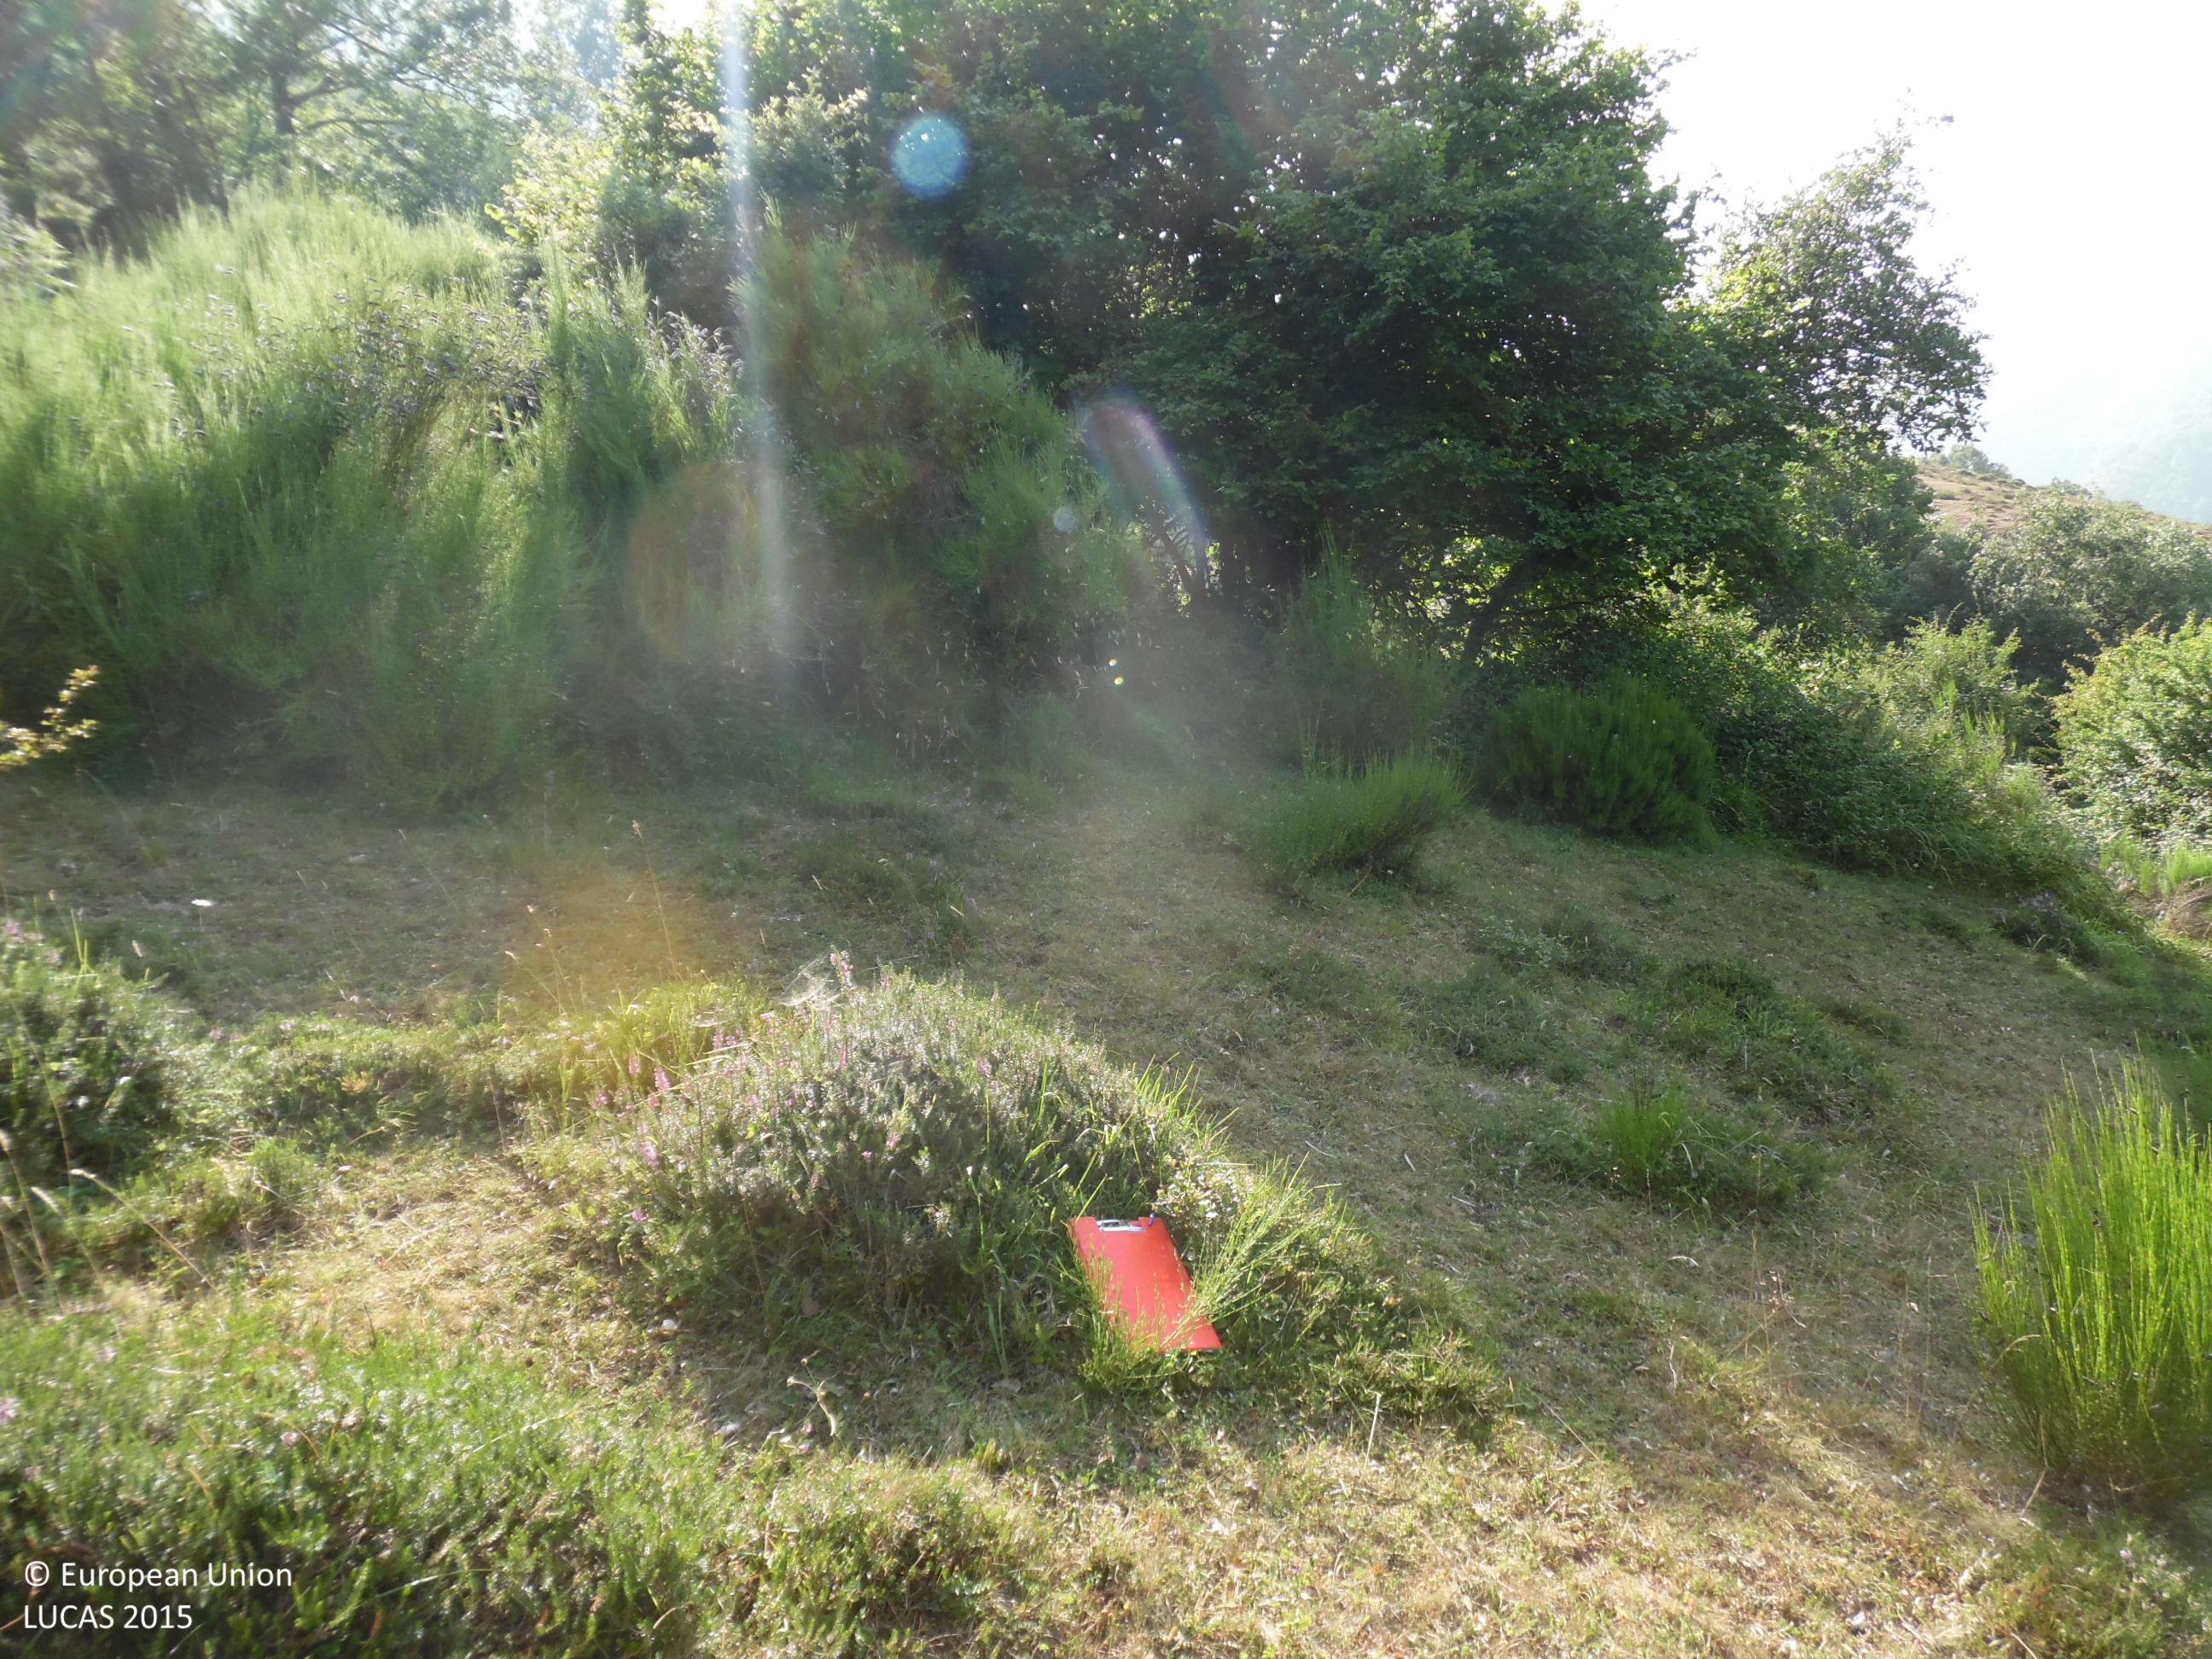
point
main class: Woodland
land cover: Broadleaved woodland
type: thermophilous deciduous forest
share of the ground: 25 - 50 %
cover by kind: herbaceous plants 50 %, broadleaved forest trees 30 %, shrubs 20 %
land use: Agriculture (excluding fallow land and kitchen gardens)
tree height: > 5 m
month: July
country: ES
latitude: 43.1312
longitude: -6.2597
